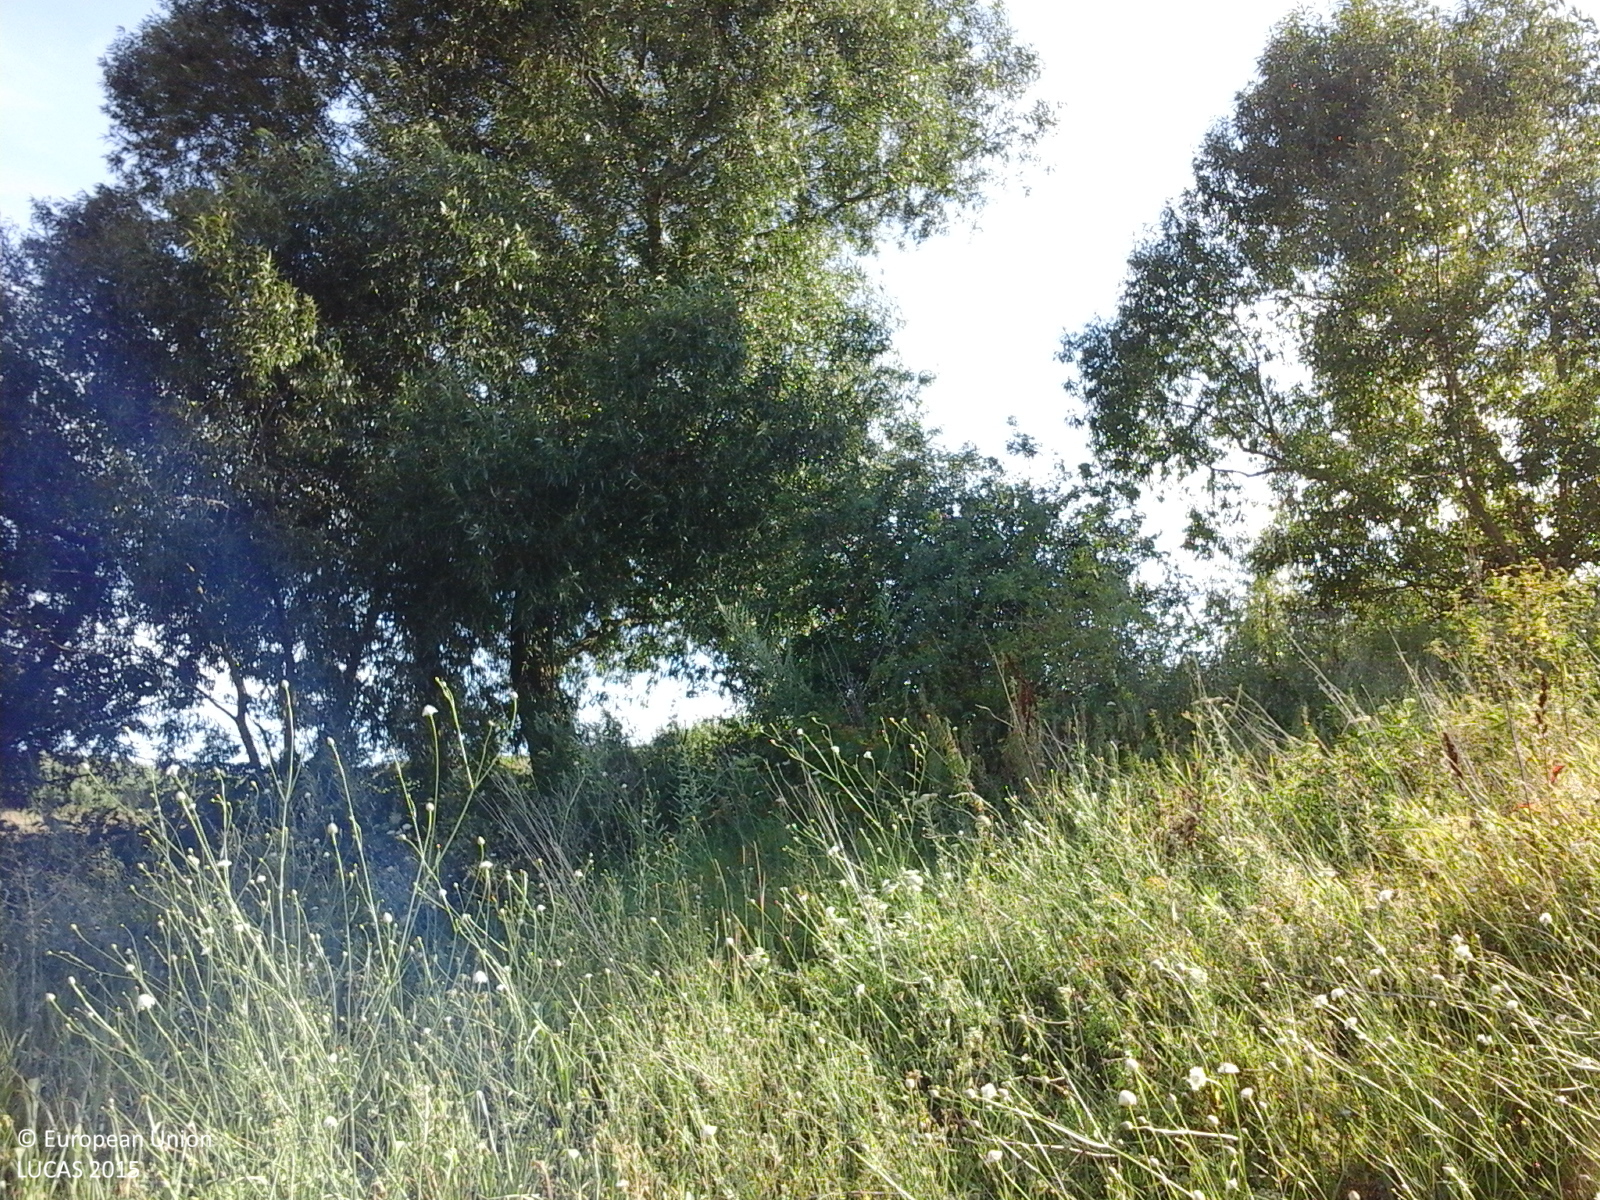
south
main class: Cropland
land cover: Maize
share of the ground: > 75 %
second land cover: Spontaneously vegetated surfaces
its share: > 75 %
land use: Agriculture (excluding fallow land and kitchen gardens)
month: July
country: RO
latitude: 46.0390
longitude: 27.6992
